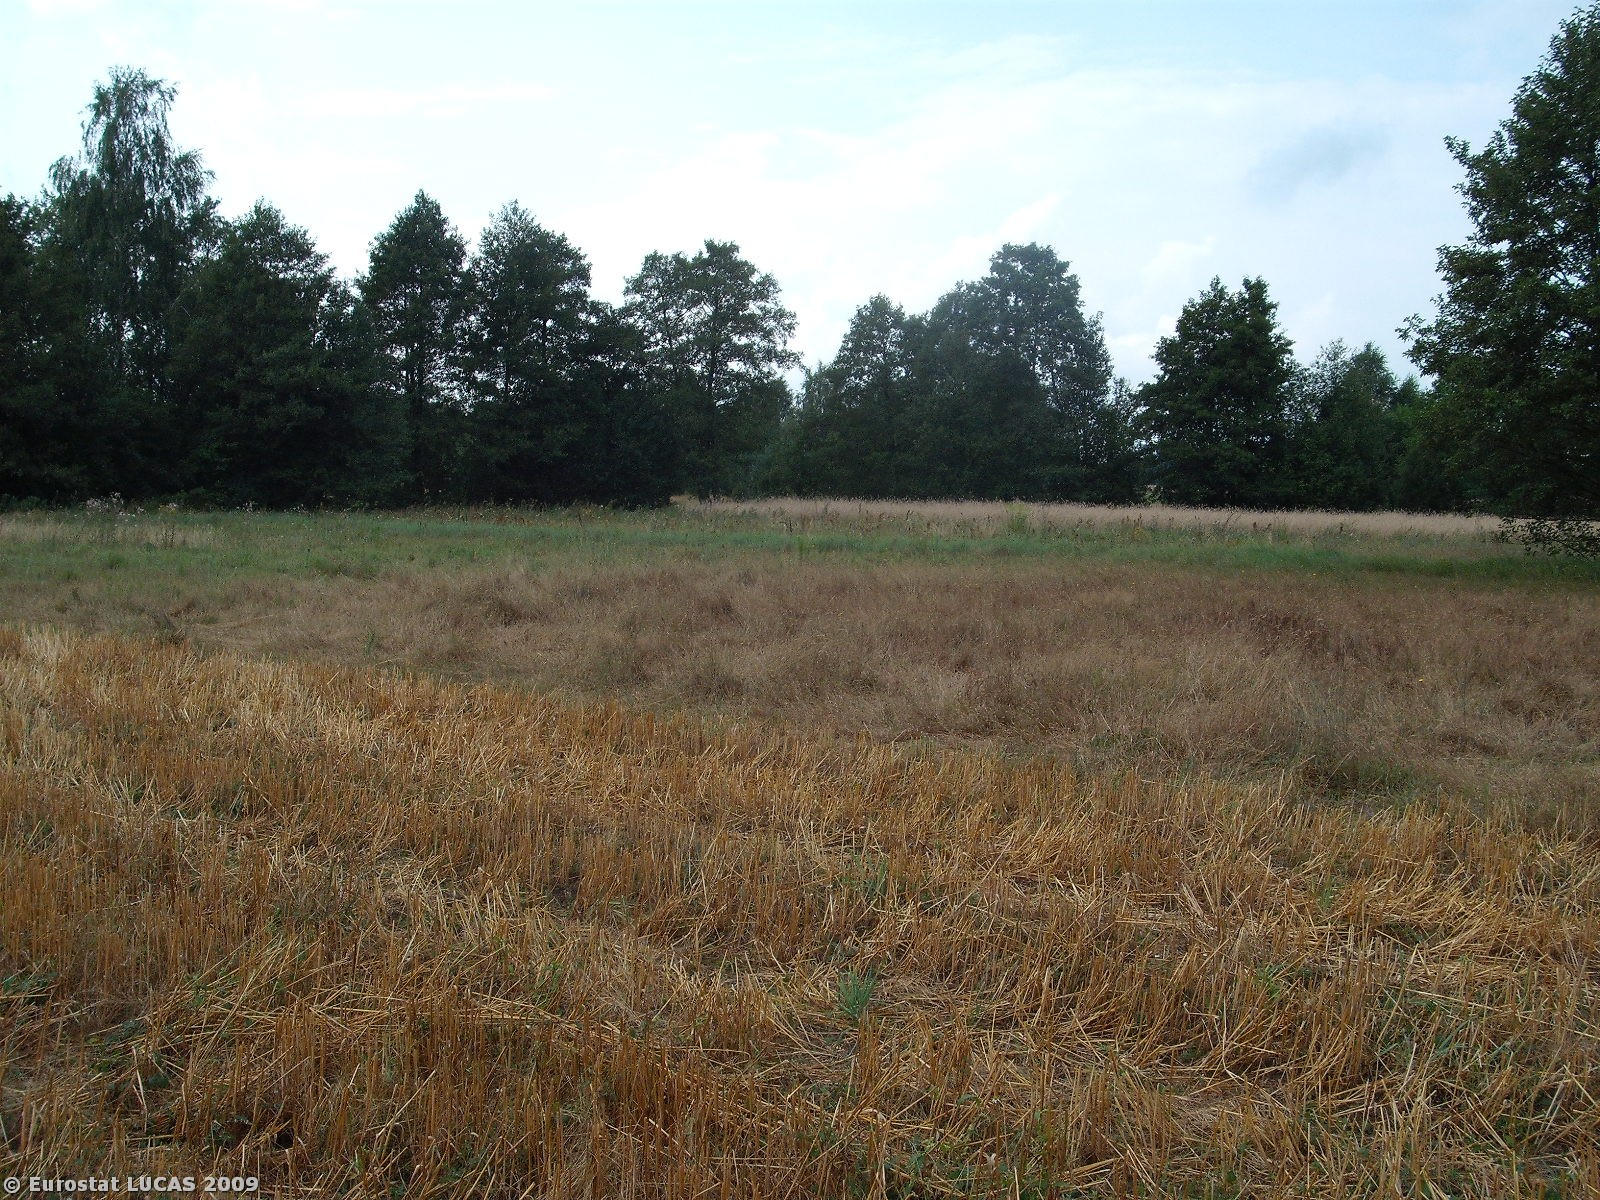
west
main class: Cropland
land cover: Rye
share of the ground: < 10 %
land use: Agriculture (excluding fallow land and kitchen gardens)
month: August
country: PL
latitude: 52.4190
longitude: 21.6544
